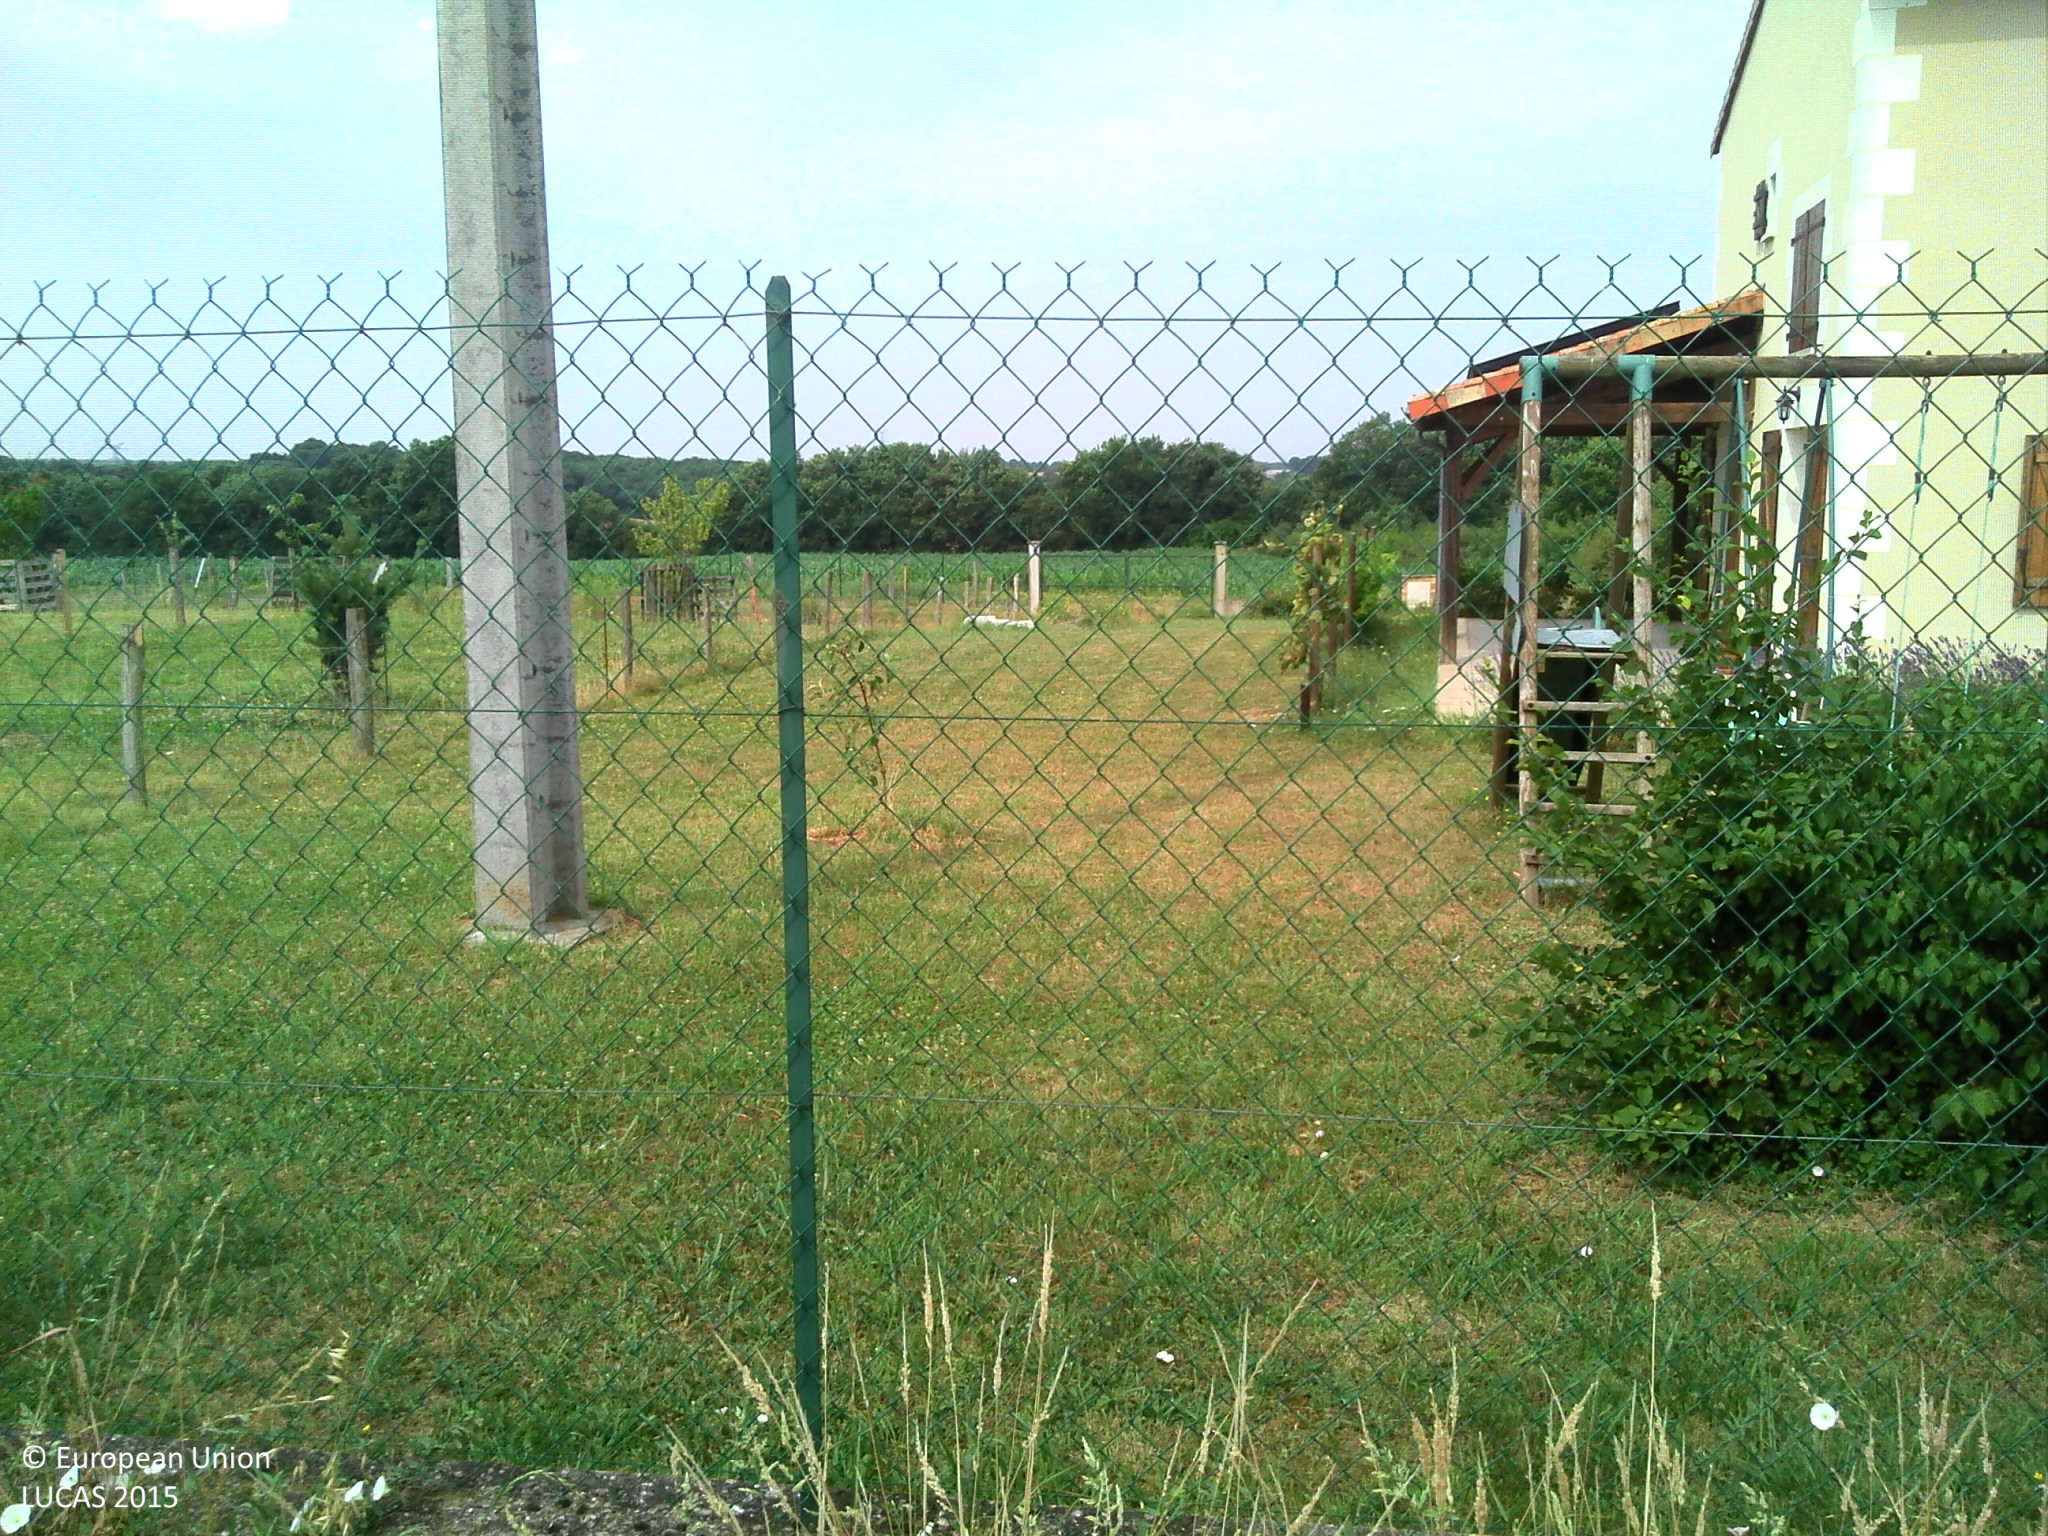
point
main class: Grassland
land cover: Grassland without tree/shrub cover
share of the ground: > 75 %
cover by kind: herbaceous plants 100 %
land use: Residential
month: July
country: FR
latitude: 46.4640
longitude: 0.6211
